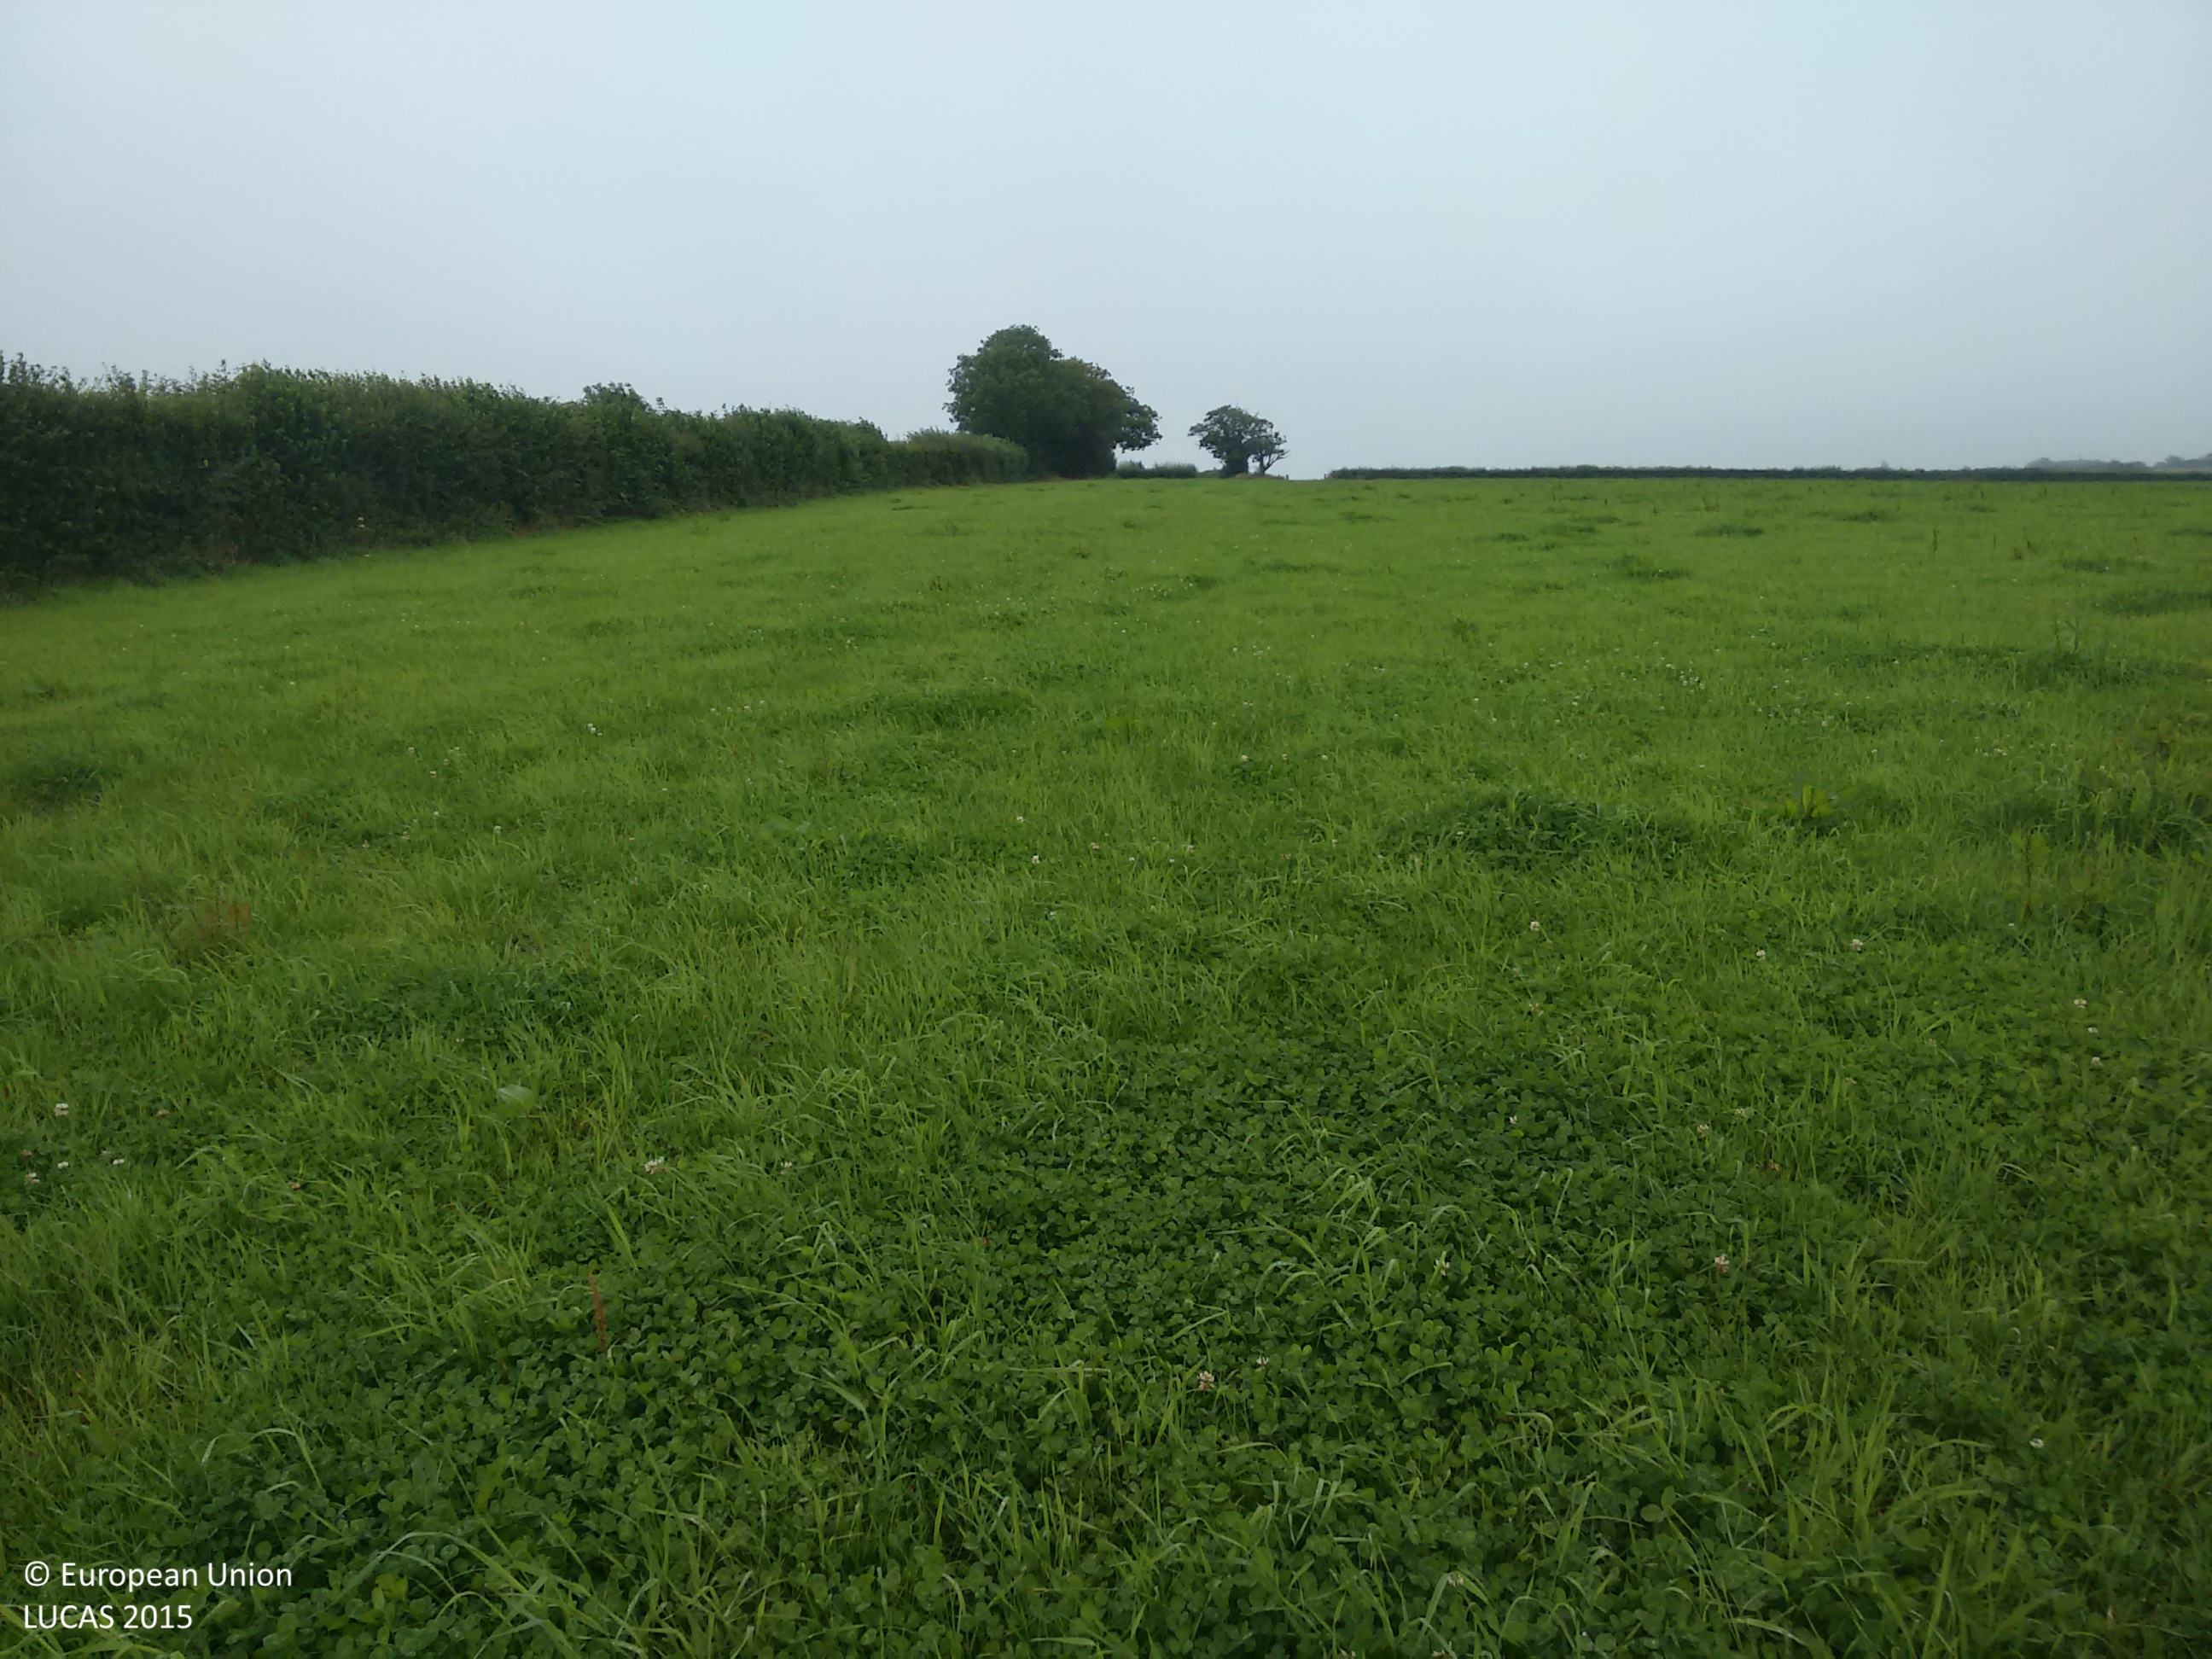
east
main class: Grassland
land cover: Grassland without tree/shrub cover
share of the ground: > 75 %
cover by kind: herbaceous plants 100 %
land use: Agriculture (excluding fallow land and kitchen gardens)
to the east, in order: Grassland without tree/shrub cover; Fences; Managed hedges; Grass margins; Managed hedges; Fences; Grassland without tree/shrub cover
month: August
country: GB
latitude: 50.8858
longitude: -3.6914
